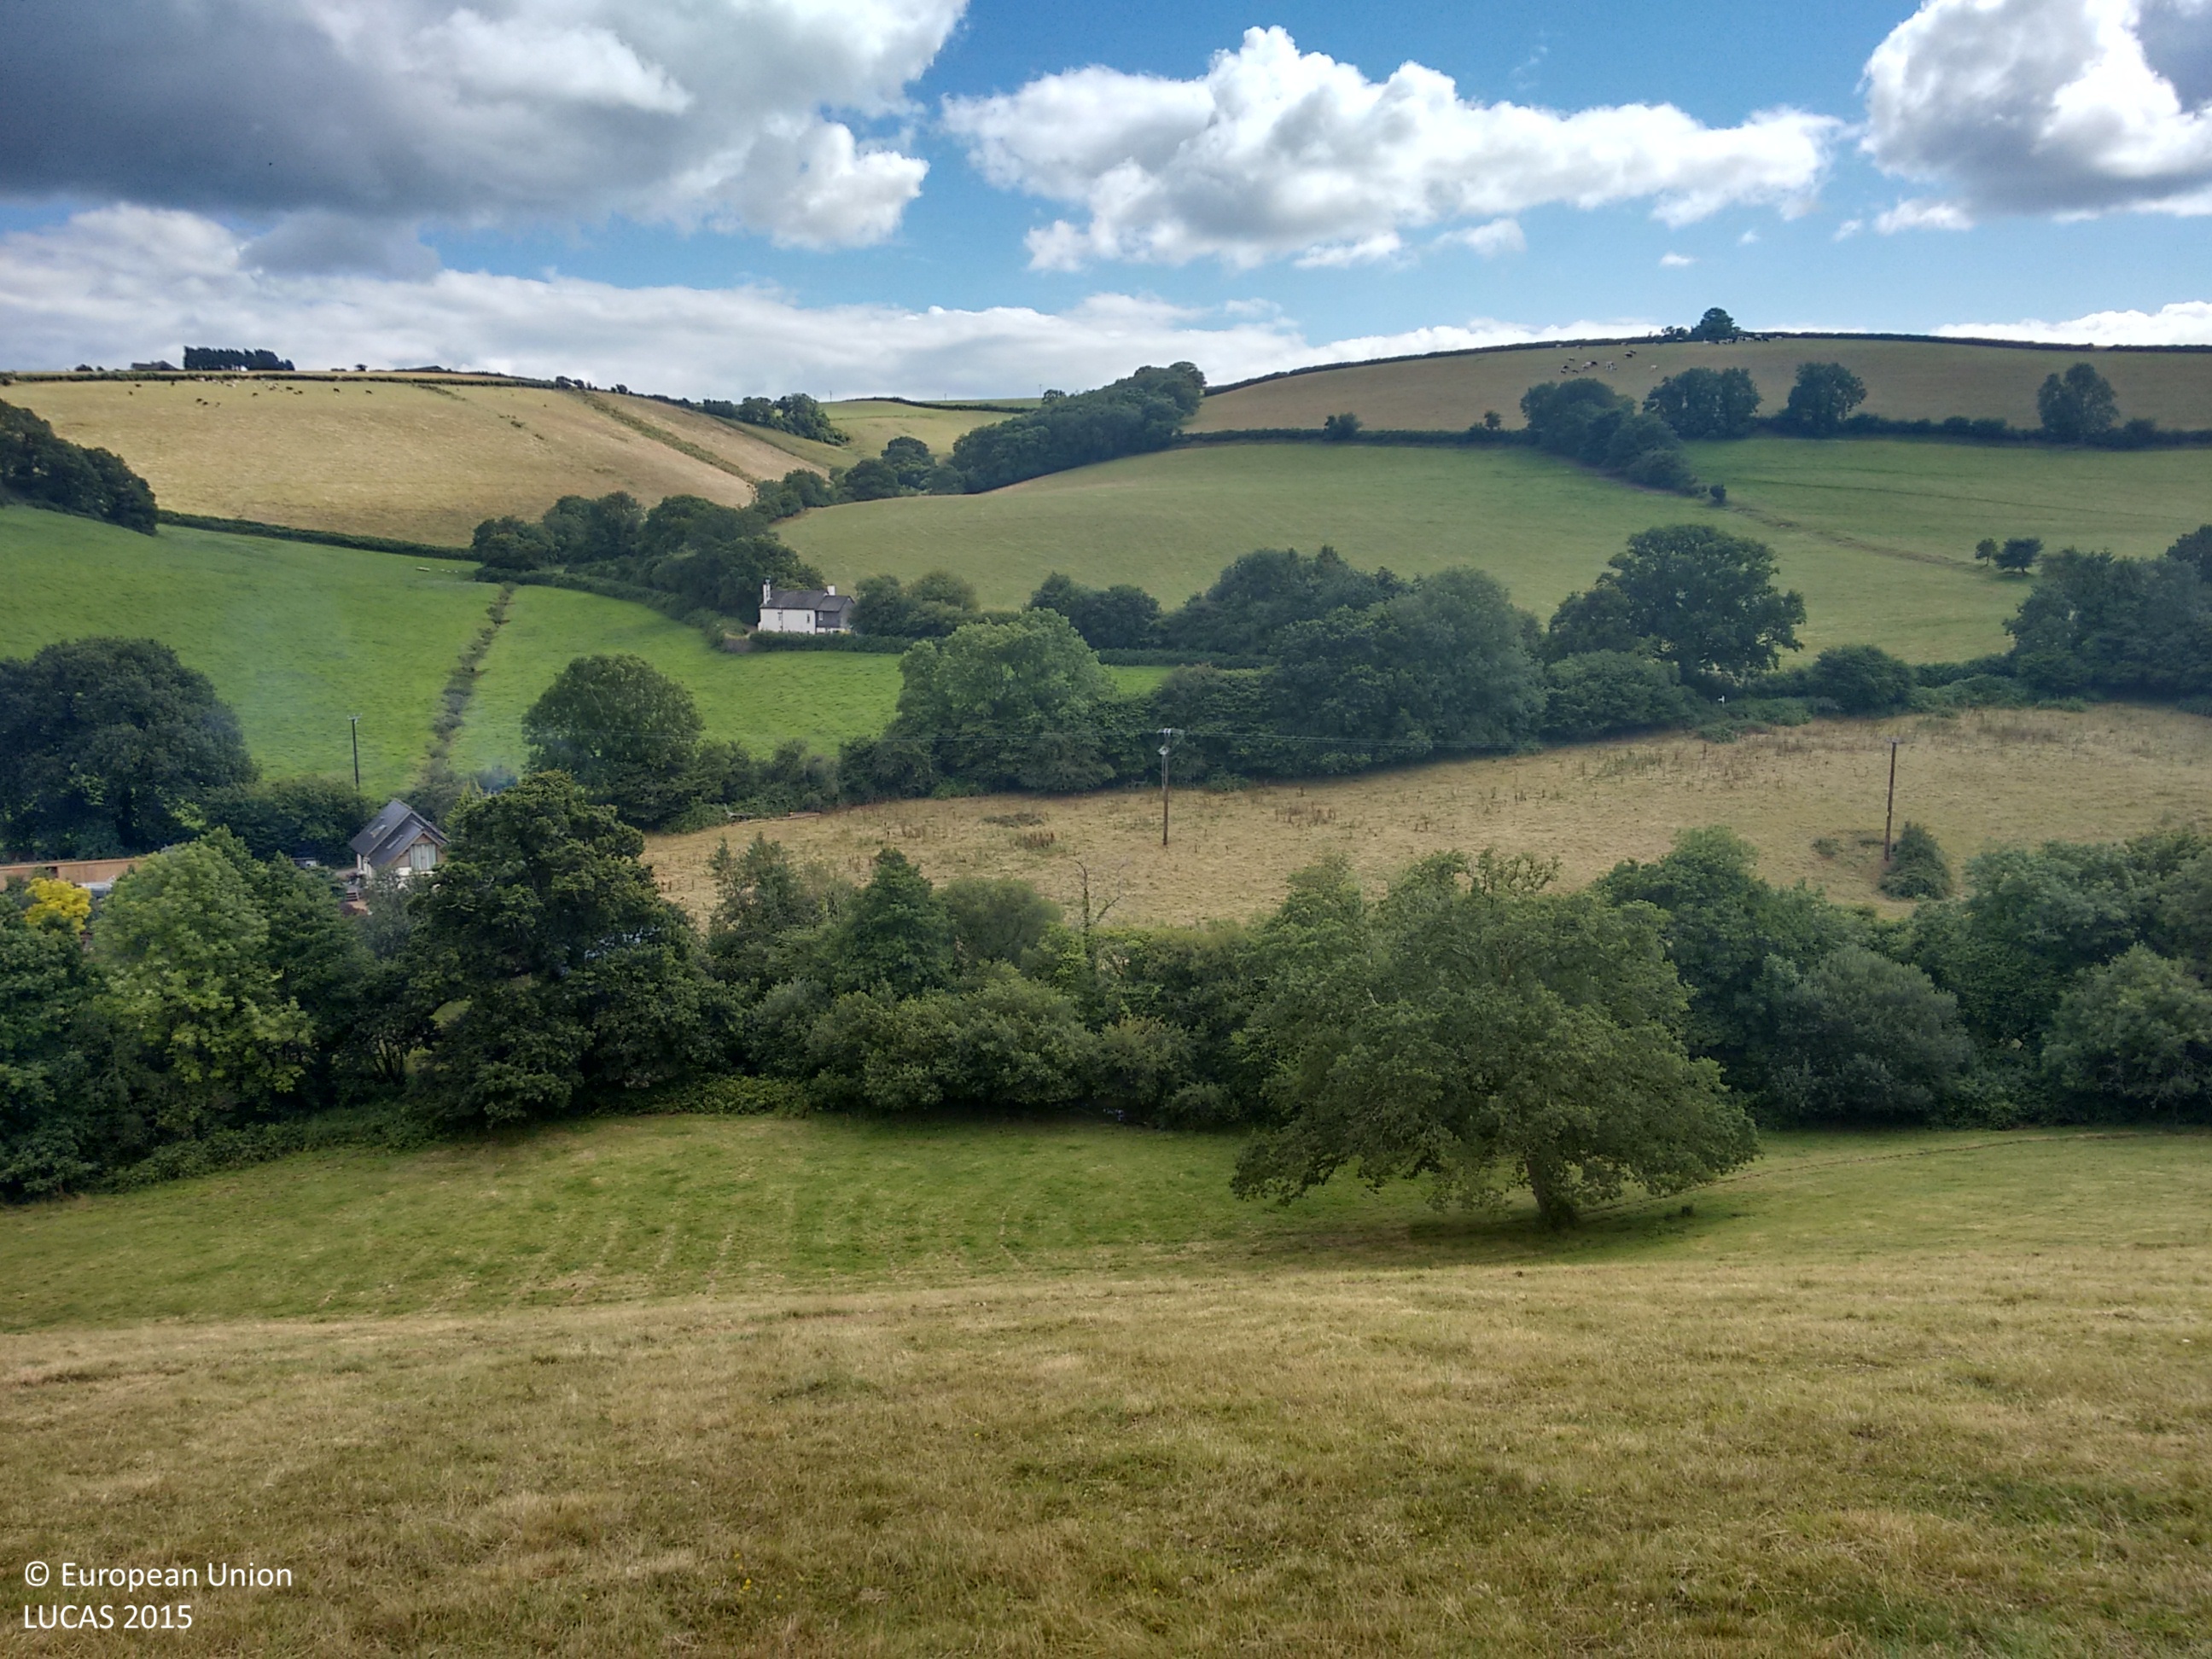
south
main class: Grassland
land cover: Grassland without tree/shrub cover
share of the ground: > 75 %
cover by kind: herbaceous plants 100 %
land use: Agriculture (excluding fallow land and kitchen gardens)
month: July
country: GB
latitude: 50.3825
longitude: -3.6290
